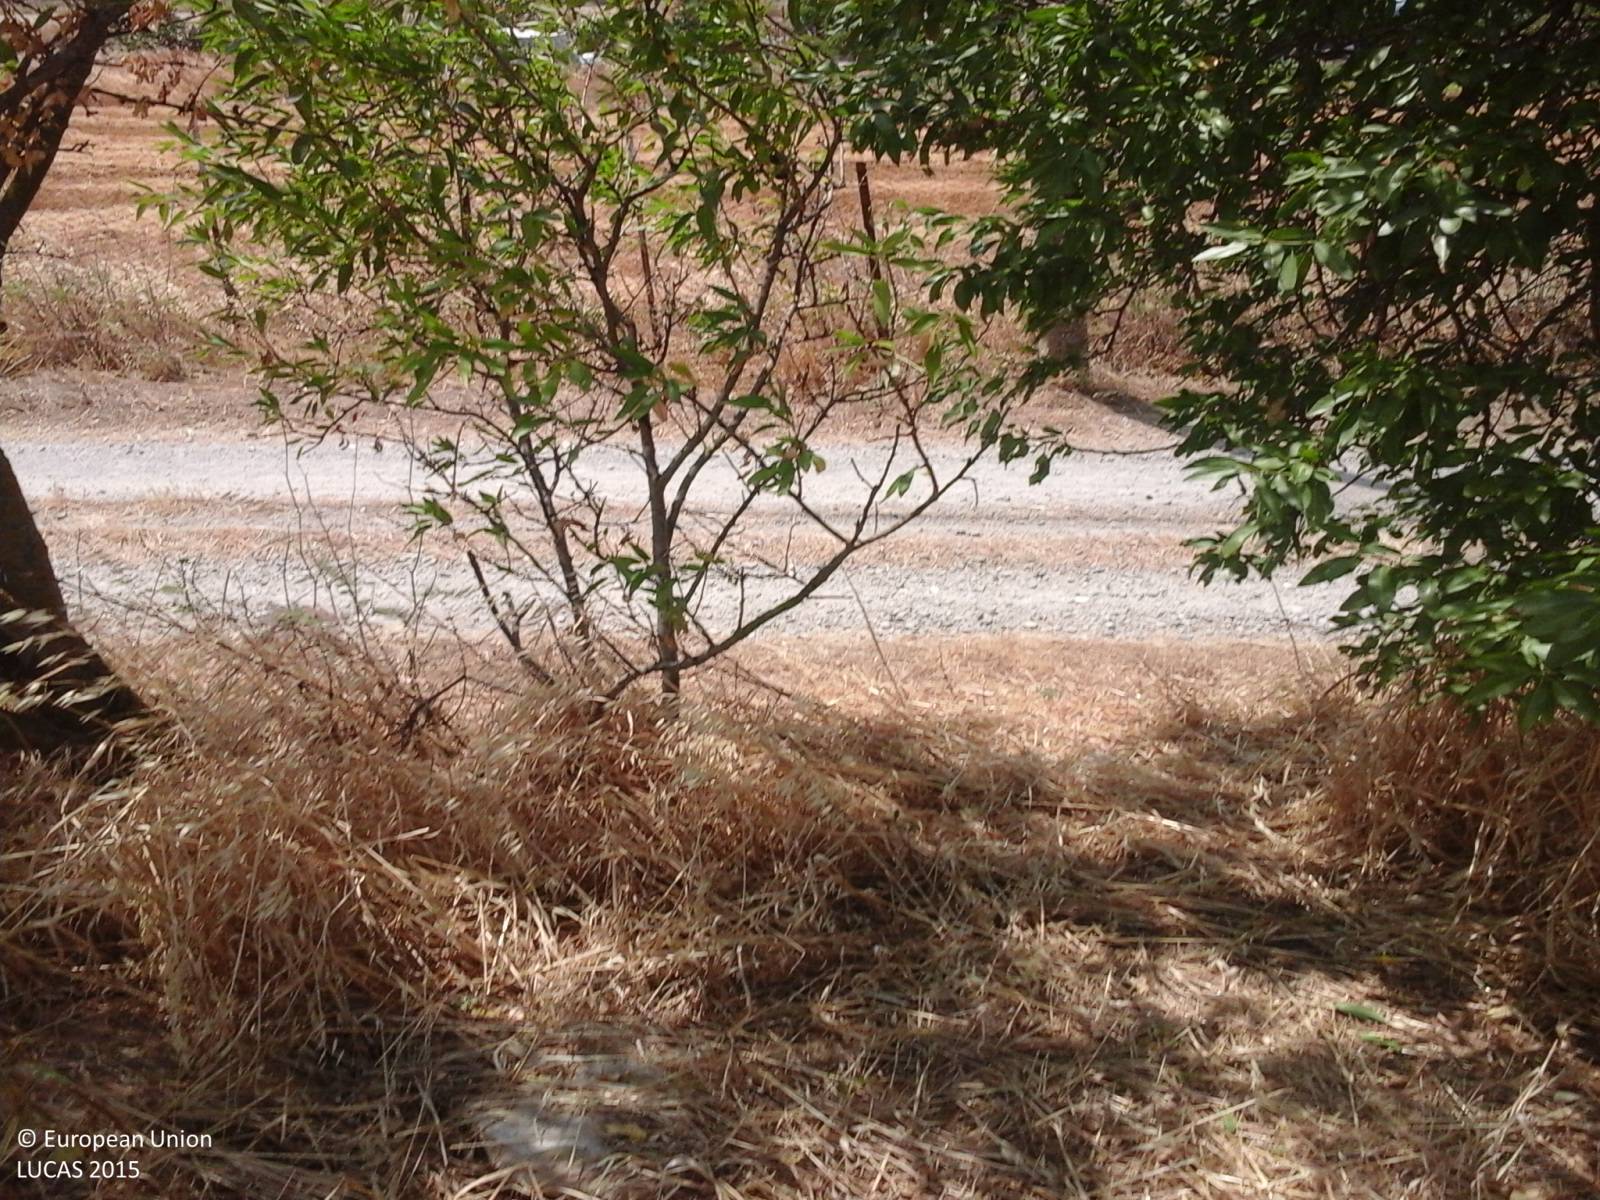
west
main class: Cropland
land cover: Barley
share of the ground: > 75 %
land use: Agriculture (excluding fallow land and kitchen gardens)
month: July
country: IT
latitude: 39.6084
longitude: 8.8305
